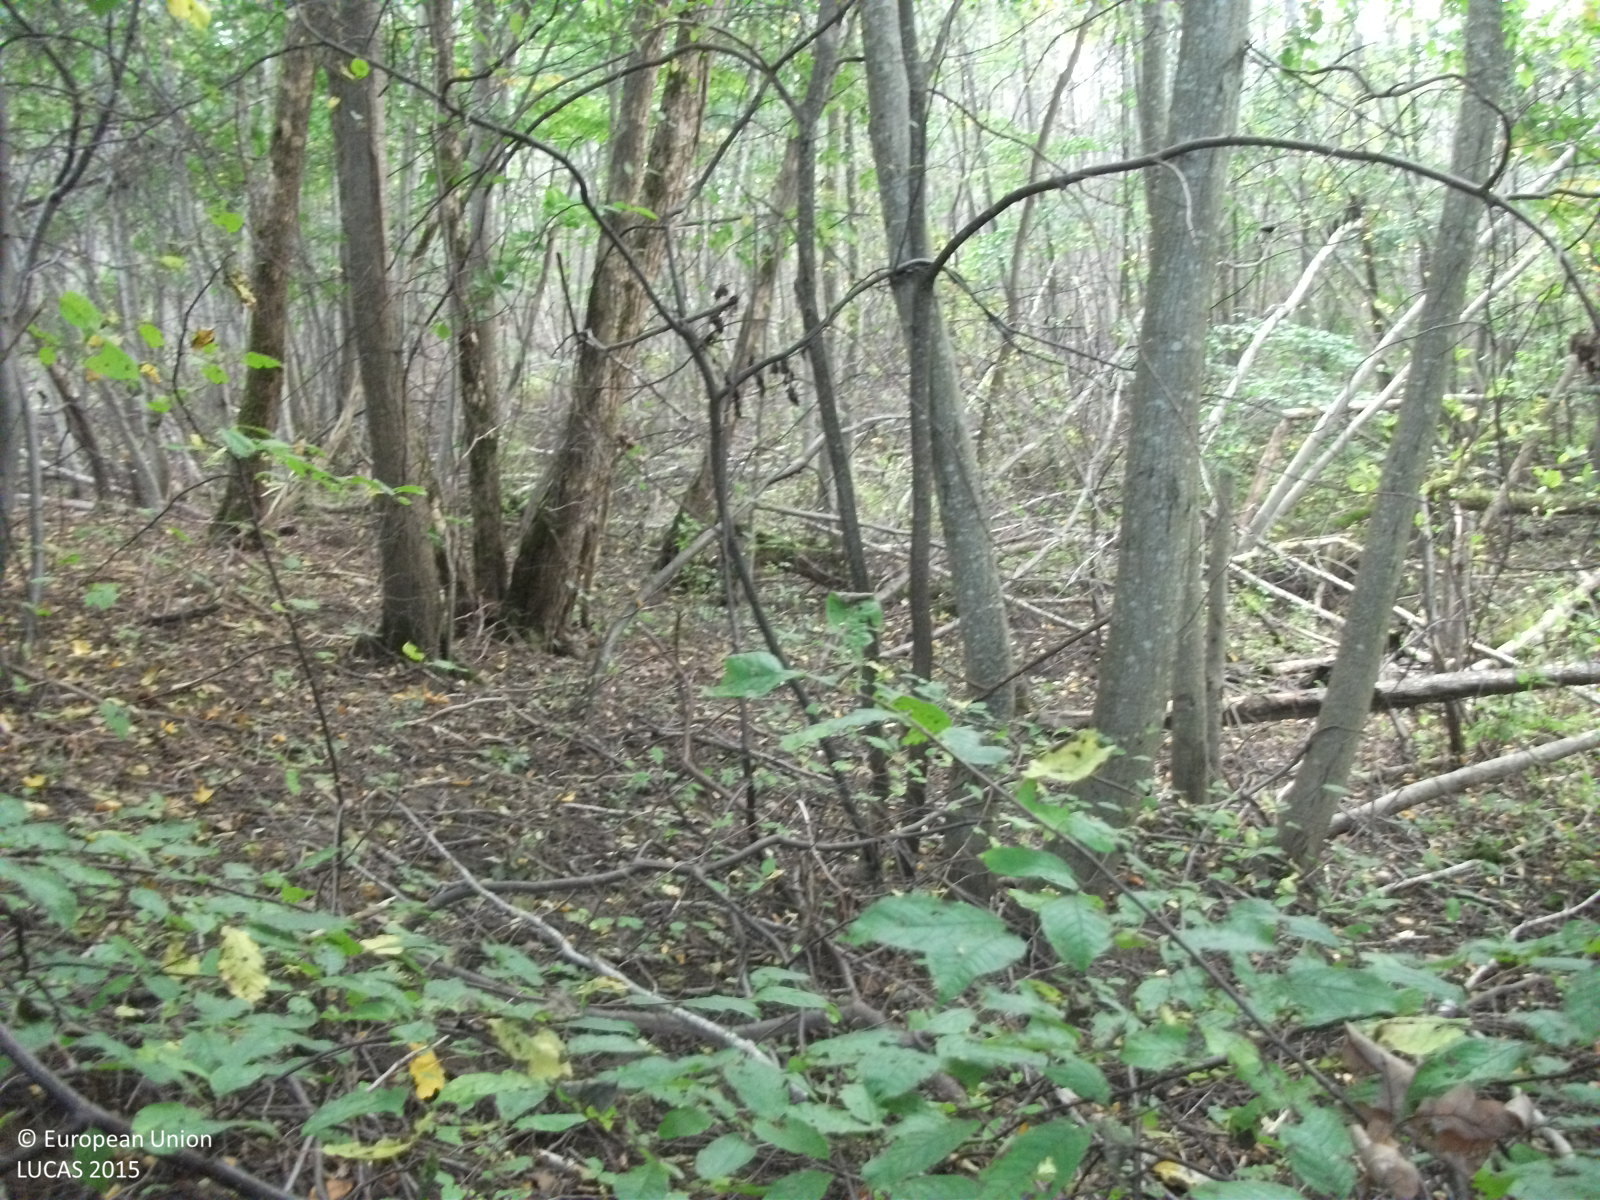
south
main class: Woodland
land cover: Broadleaved woodland
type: non-riverine alder, birch or aspen forest
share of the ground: > 75 %
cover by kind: broadleaved forest trees 90 %, herbaceous plants 5 %, unconsolidated bare surface 5 %
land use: Semi-natural and natural areas not in use
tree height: > 5 m
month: September
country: LV
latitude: 57.8872
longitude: 24.6477
